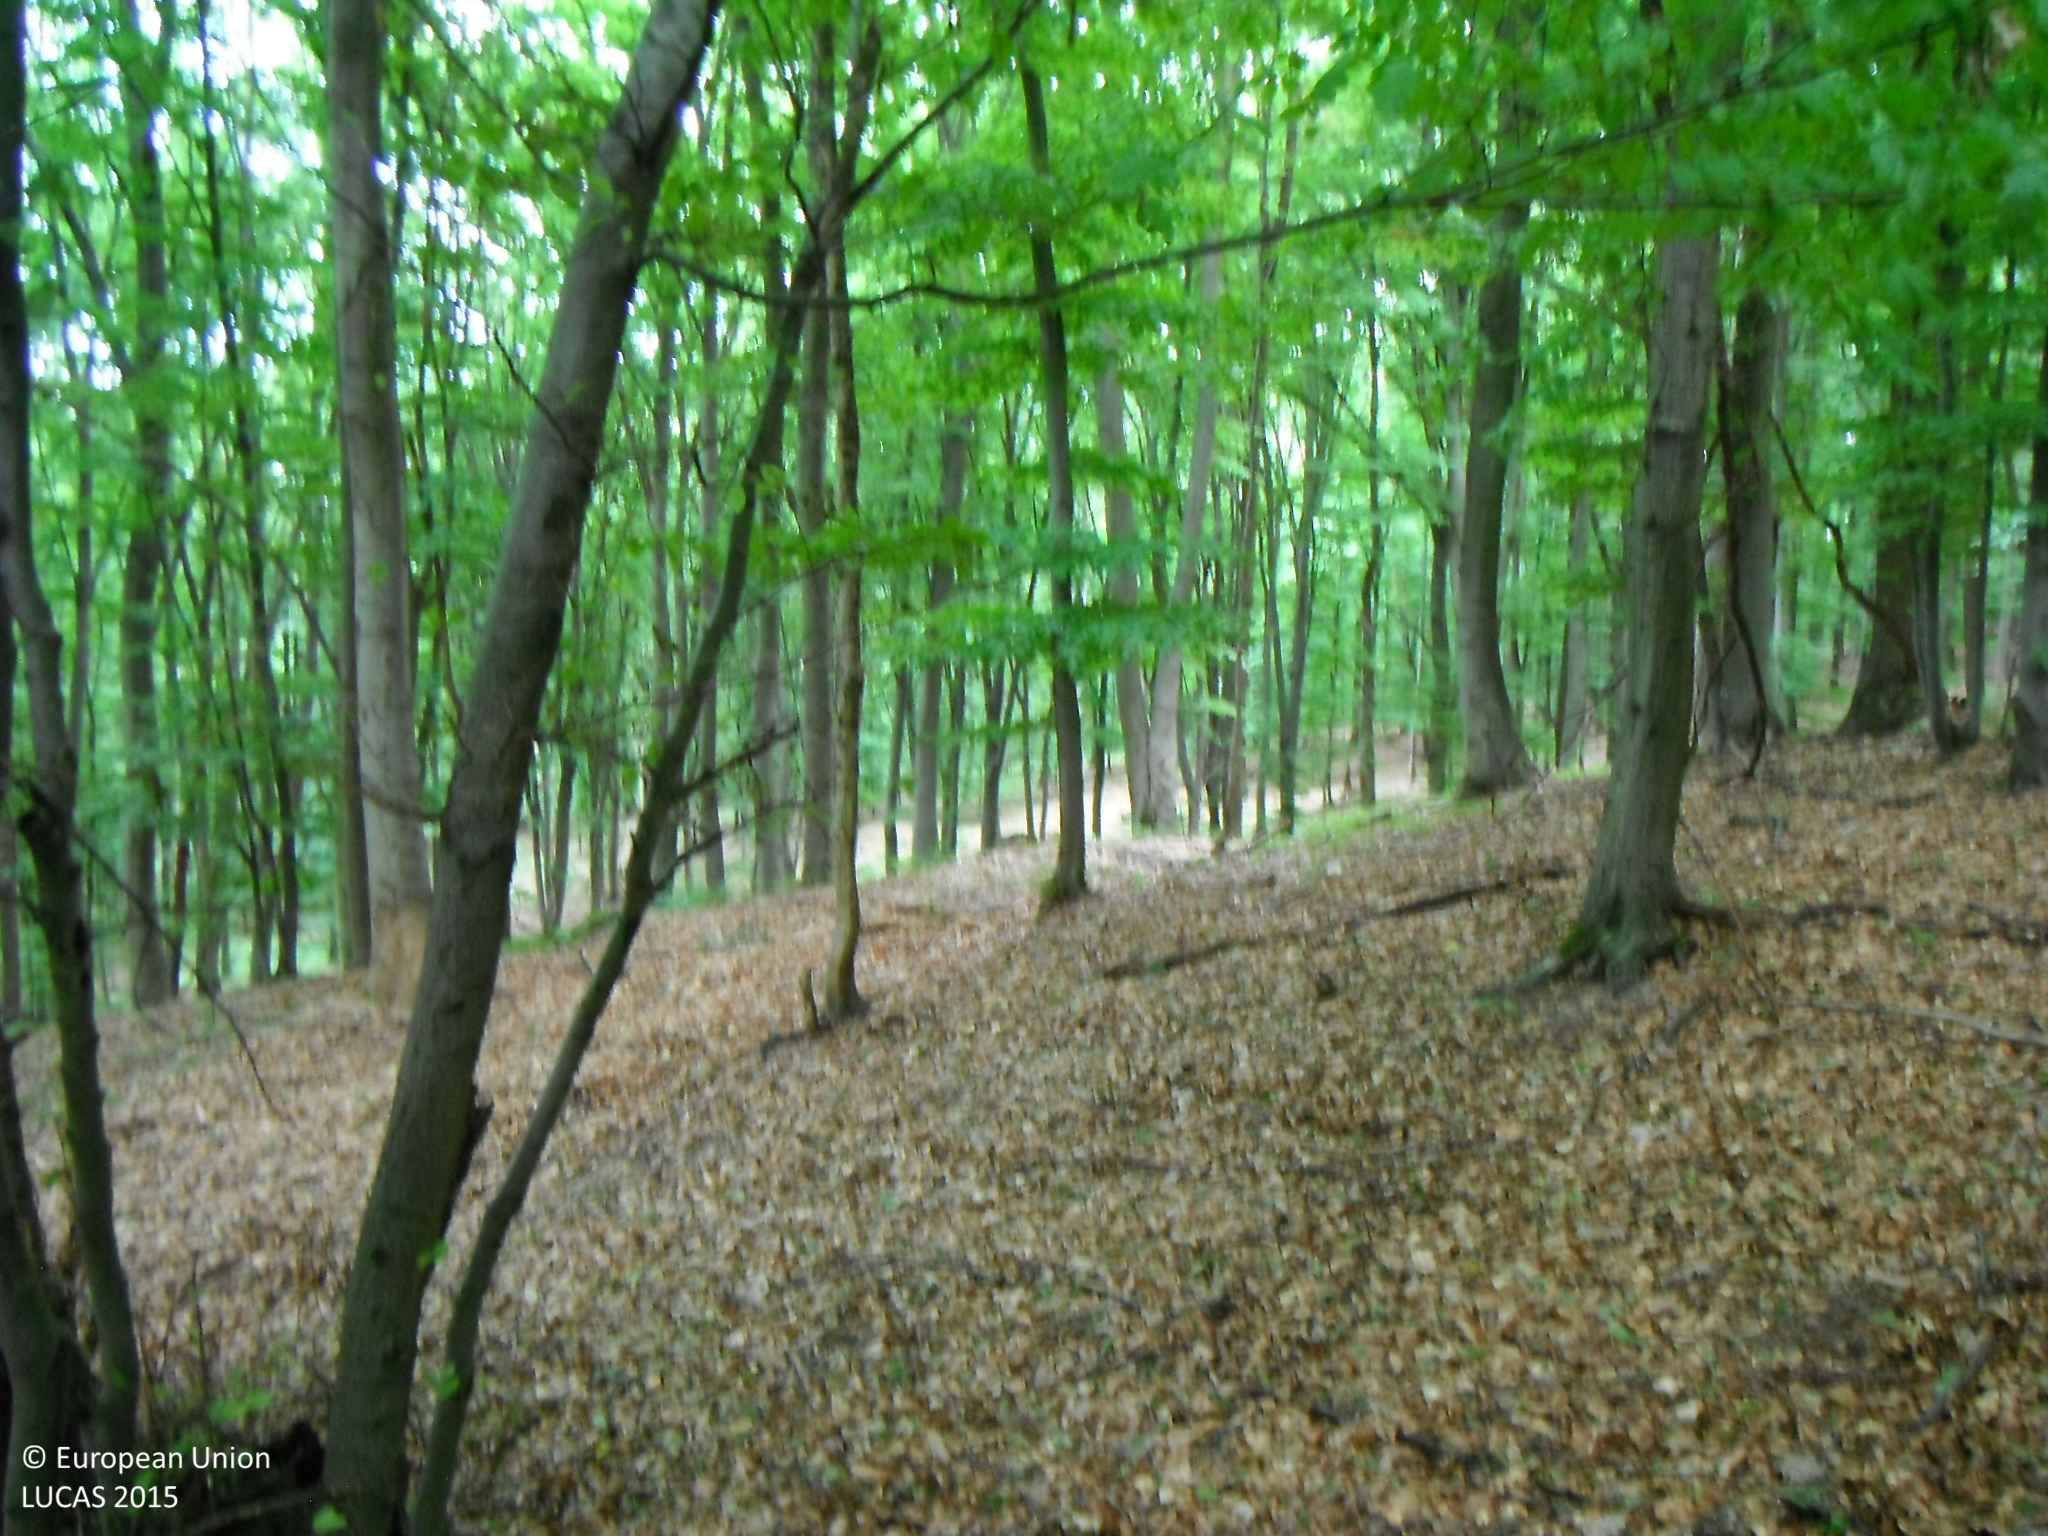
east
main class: Woodland
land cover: Broadleaved woodland
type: beech forest
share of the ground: > 75 %
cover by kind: broadleaved forest trees 100 %
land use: Forestry
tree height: > 5 m
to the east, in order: Broadleaved woodland; Tracks; Broadleaved woodland
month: July
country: SK
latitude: 48.2588
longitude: 19.9830
